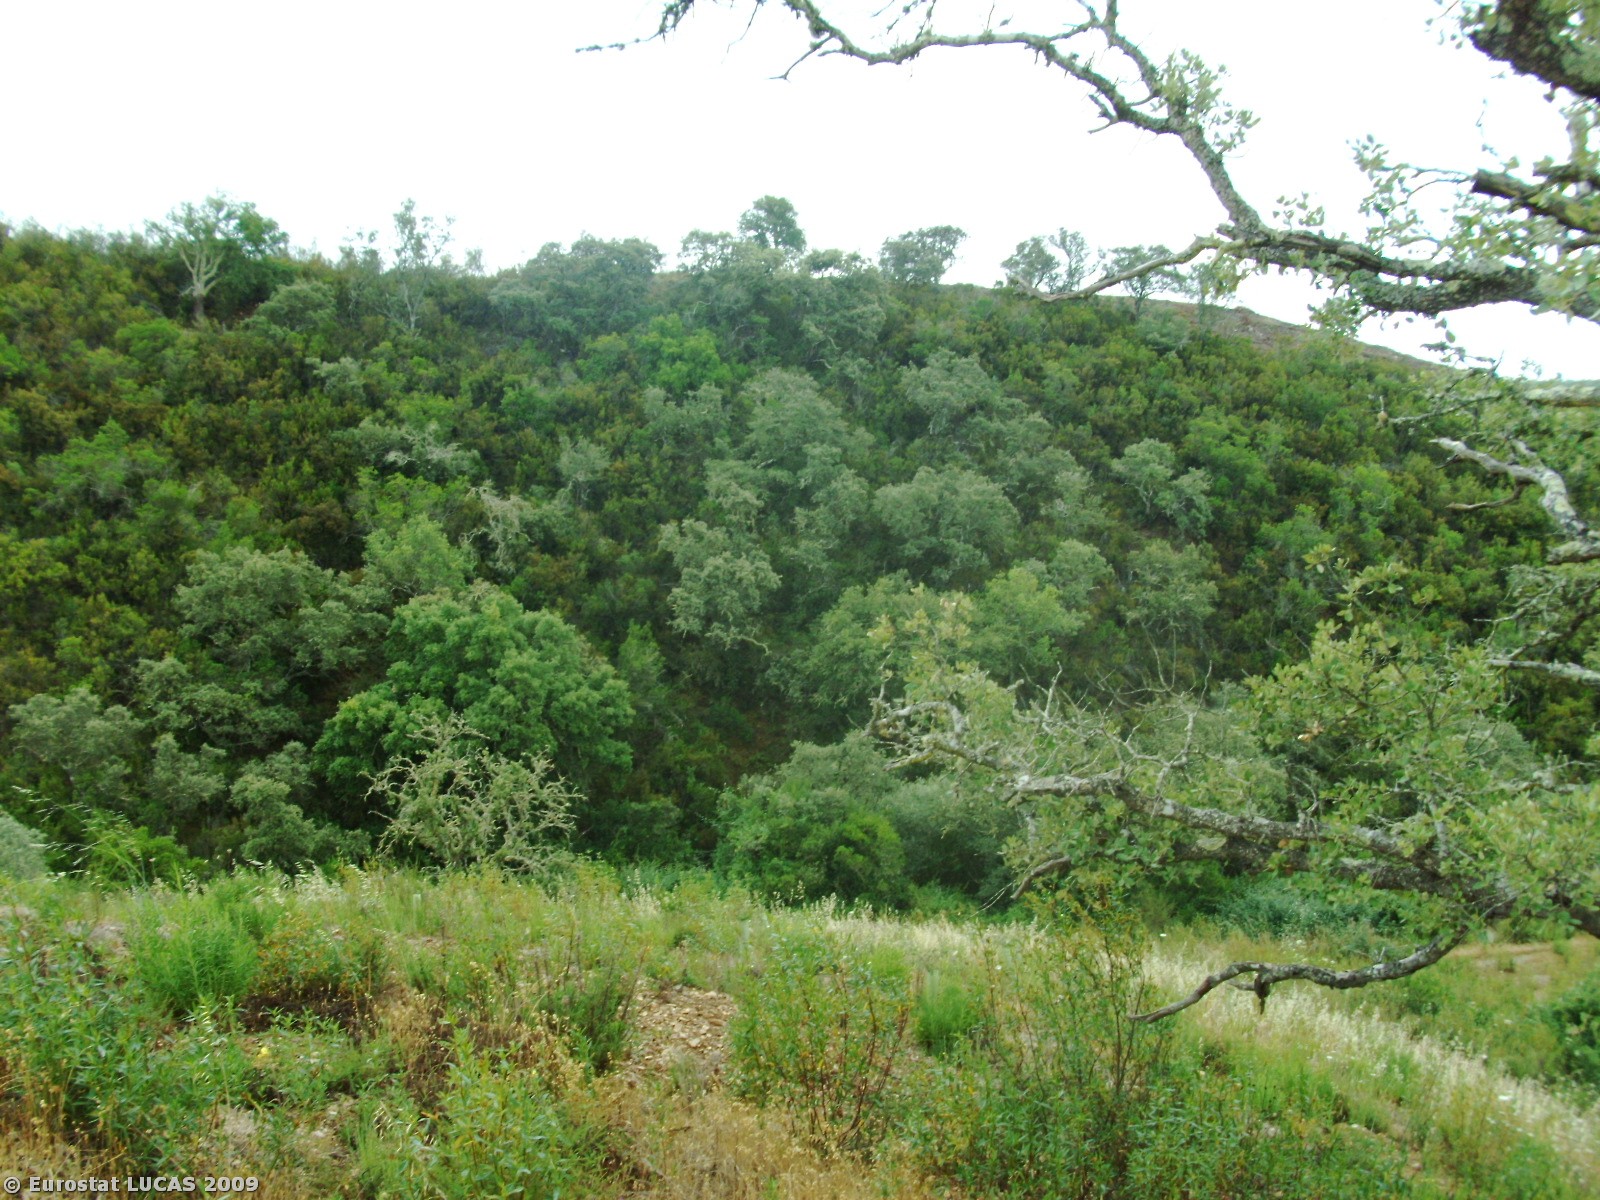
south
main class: Woodland
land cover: Broadleaved woodland
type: broadleaved evergreen forest
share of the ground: 10 - 25 %
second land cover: Spontaneously vegetated surfaces
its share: 50 - 75 %
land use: Forestry
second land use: Fallow land
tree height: > 5 m
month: June
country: PT
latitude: 37.4595
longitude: -8.4700
